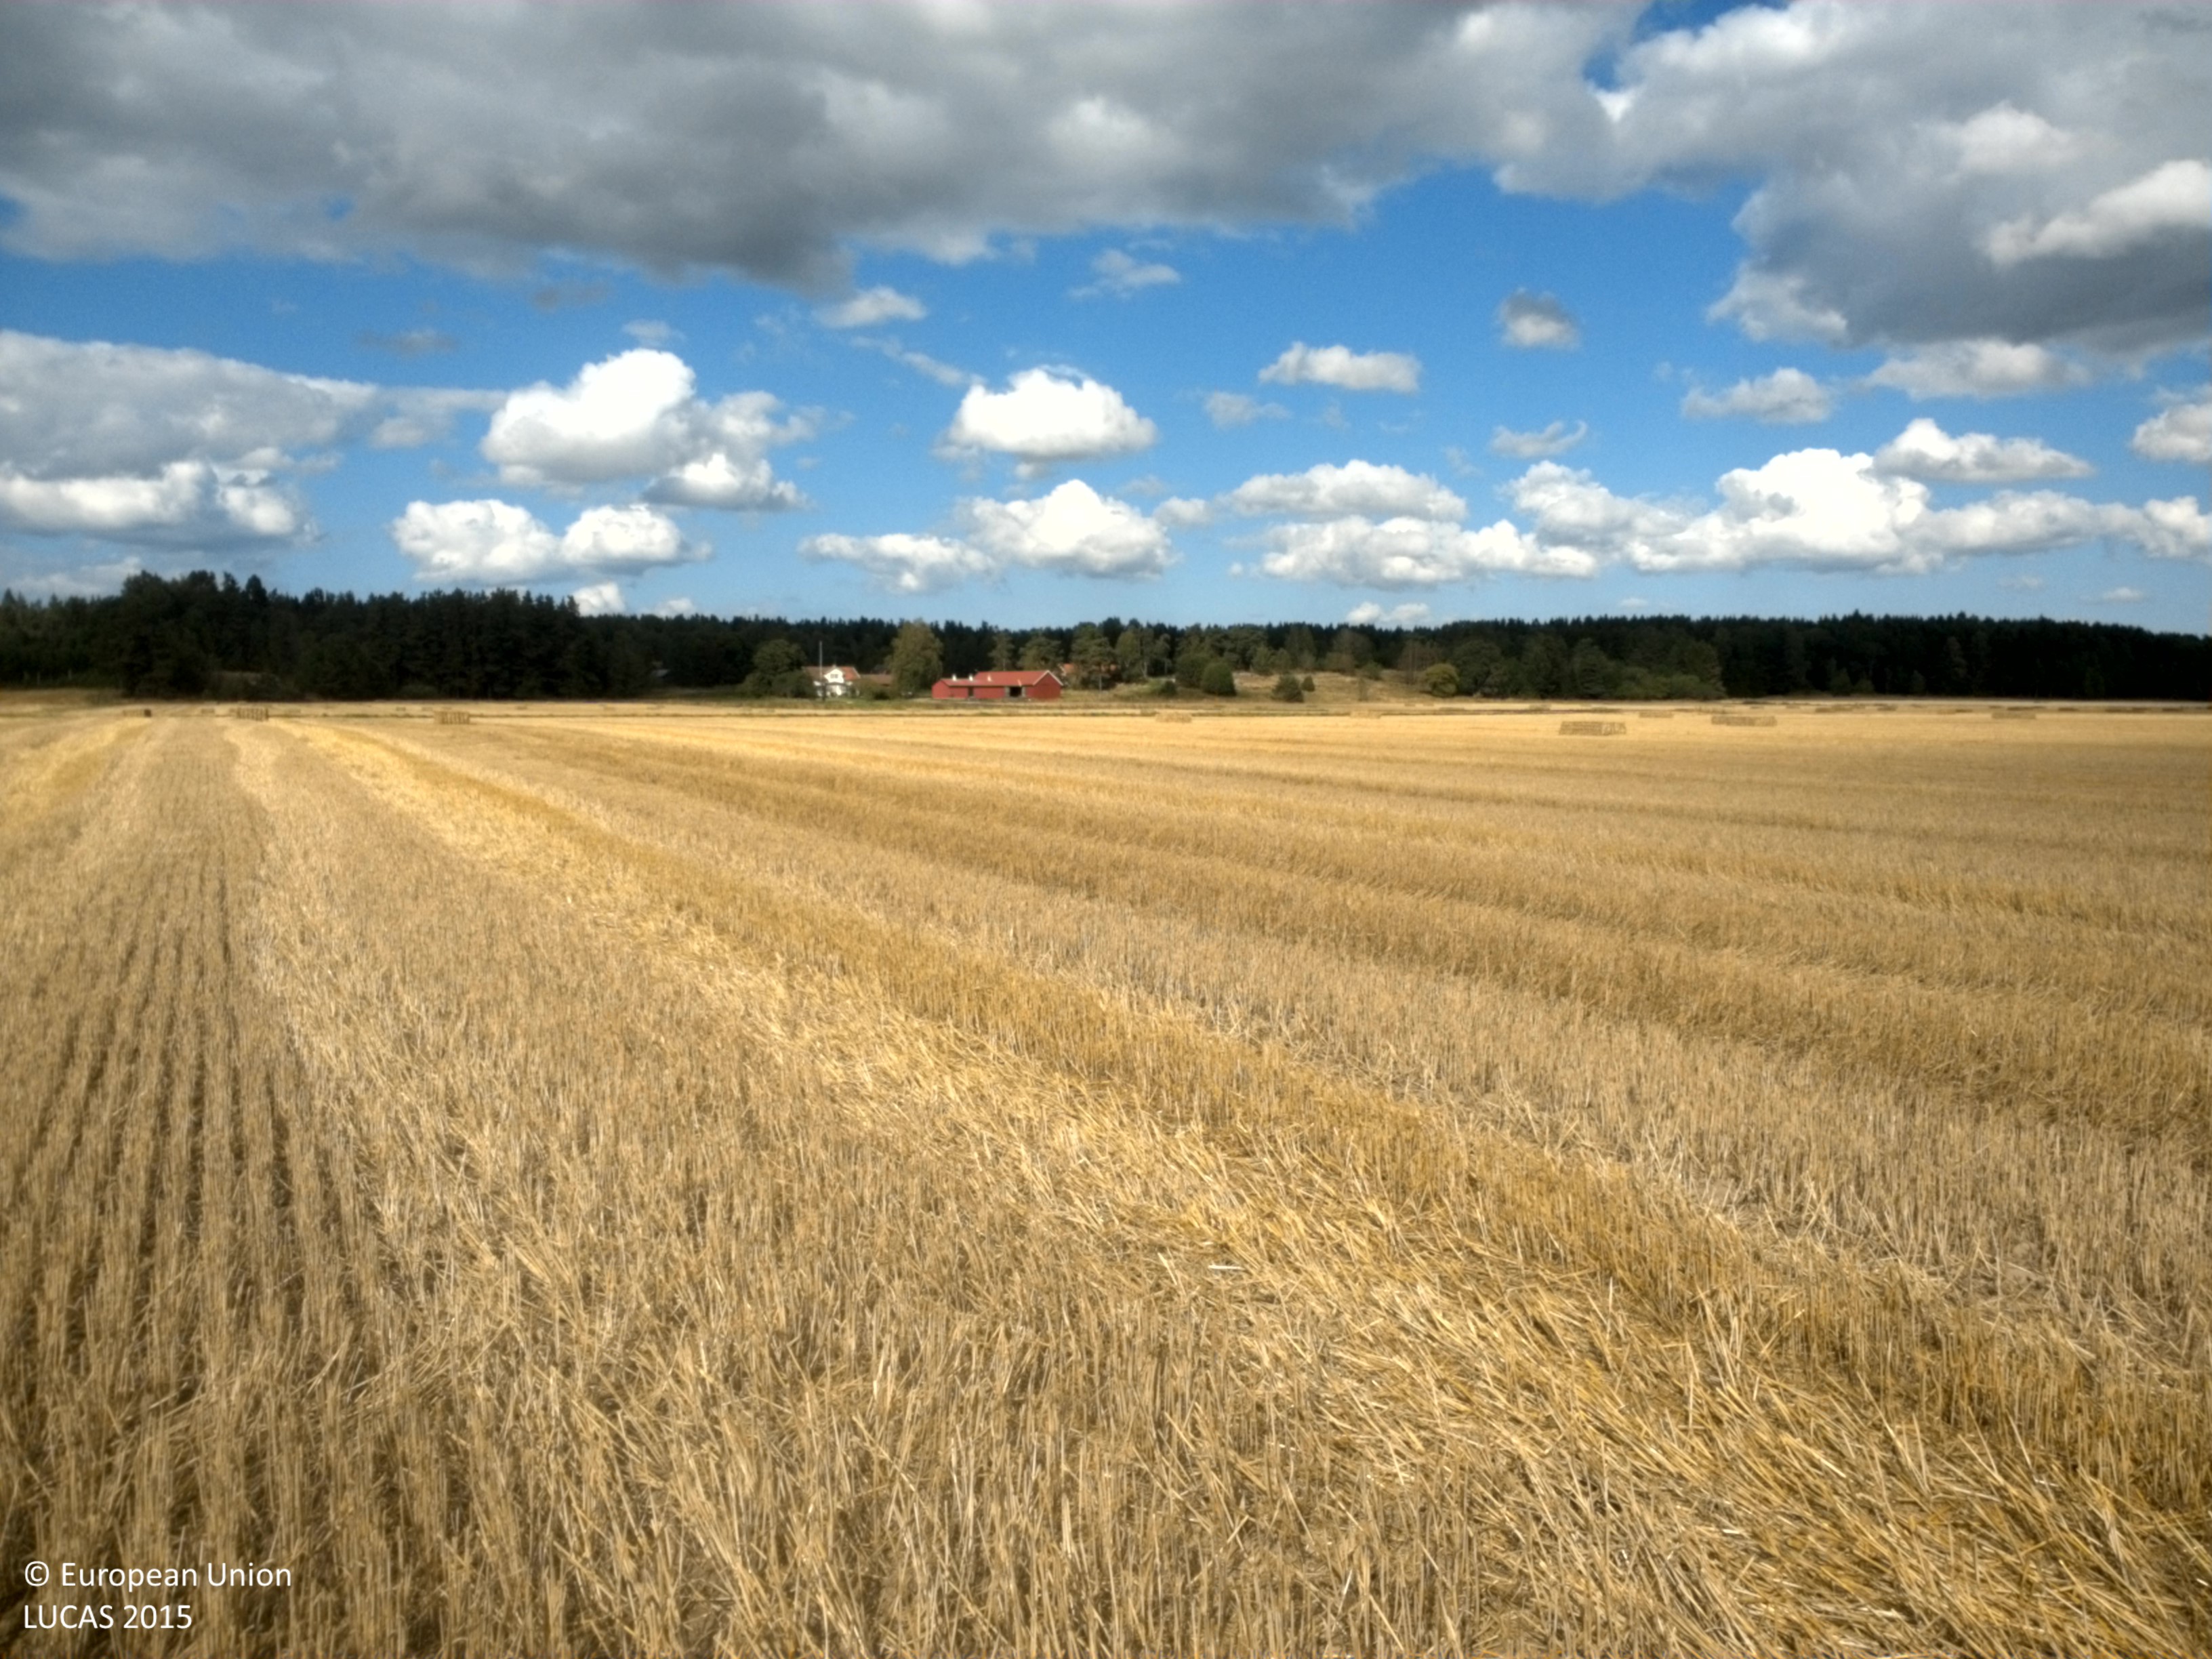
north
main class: Cropland
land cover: Common wheat
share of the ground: 50 - 75 %
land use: Agriculture (excluding fallow land and kitchen gardens)
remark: Harvested field
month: September
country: SE
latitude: 58.3499
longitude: 12.9164
